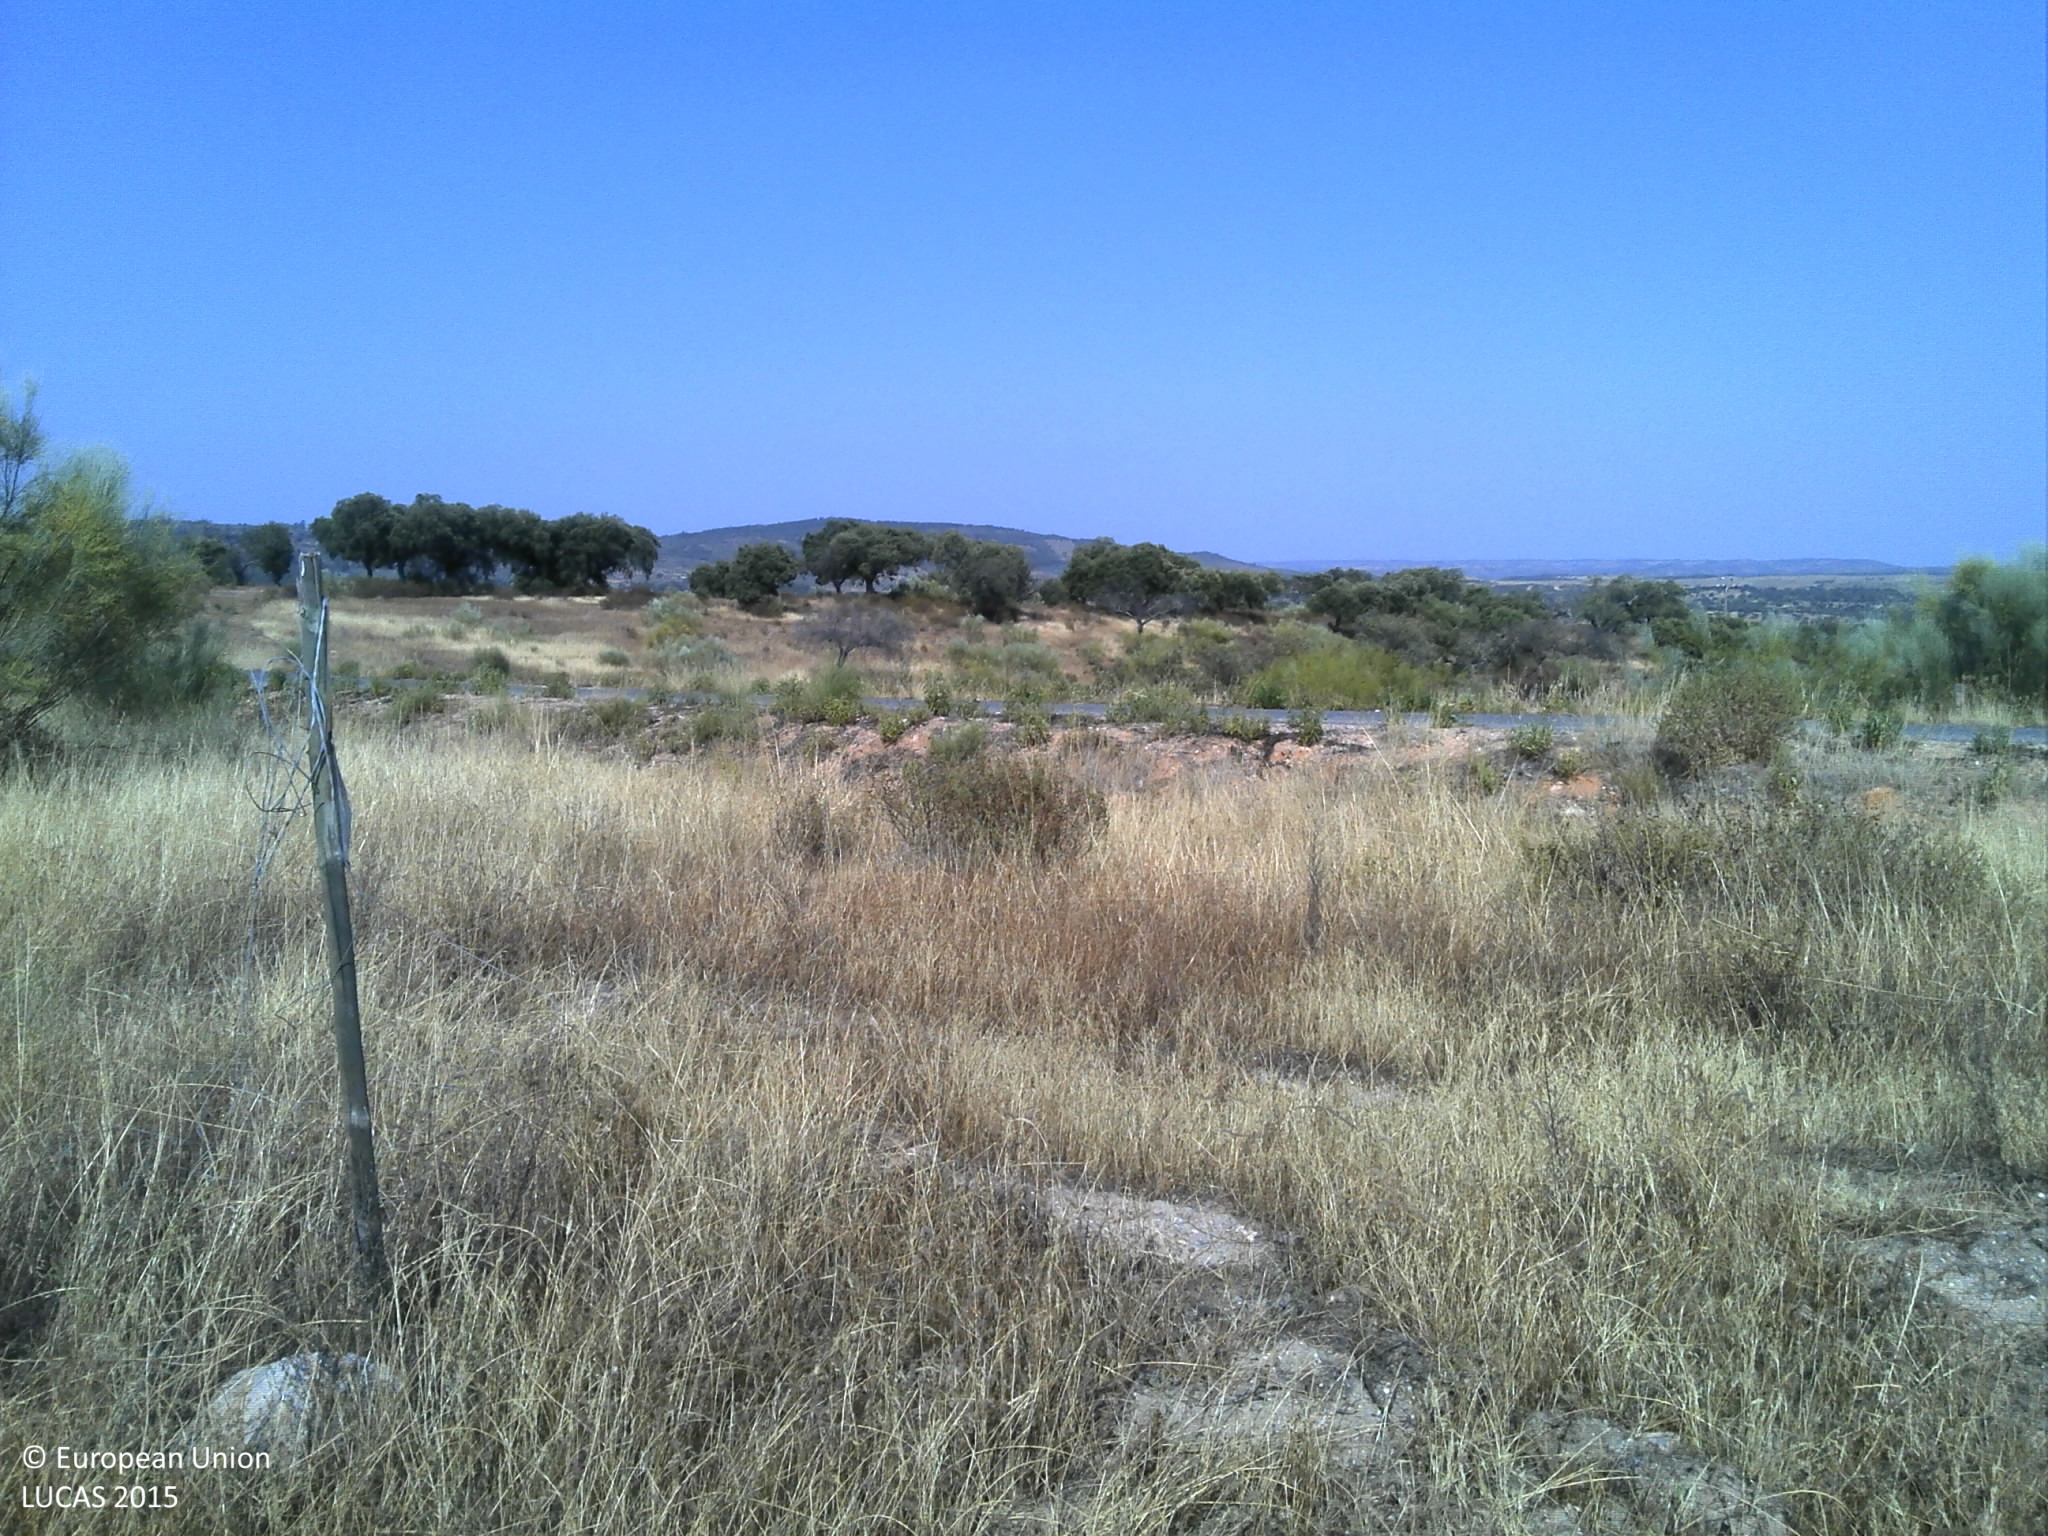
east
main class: Woodland
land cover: Broadleaved woodland
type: broadleaved evergreen forest
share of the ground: 25 - 50 %
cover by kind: herbaceous plants 55 %, broadleaved forest trees 45 %
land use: Forestry
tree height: > 5 m
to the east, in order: Broadleaved woodland; Rivers and streams; Broadleaved woodland
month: June
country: PT
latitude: 39.7234
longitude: -7.3483
